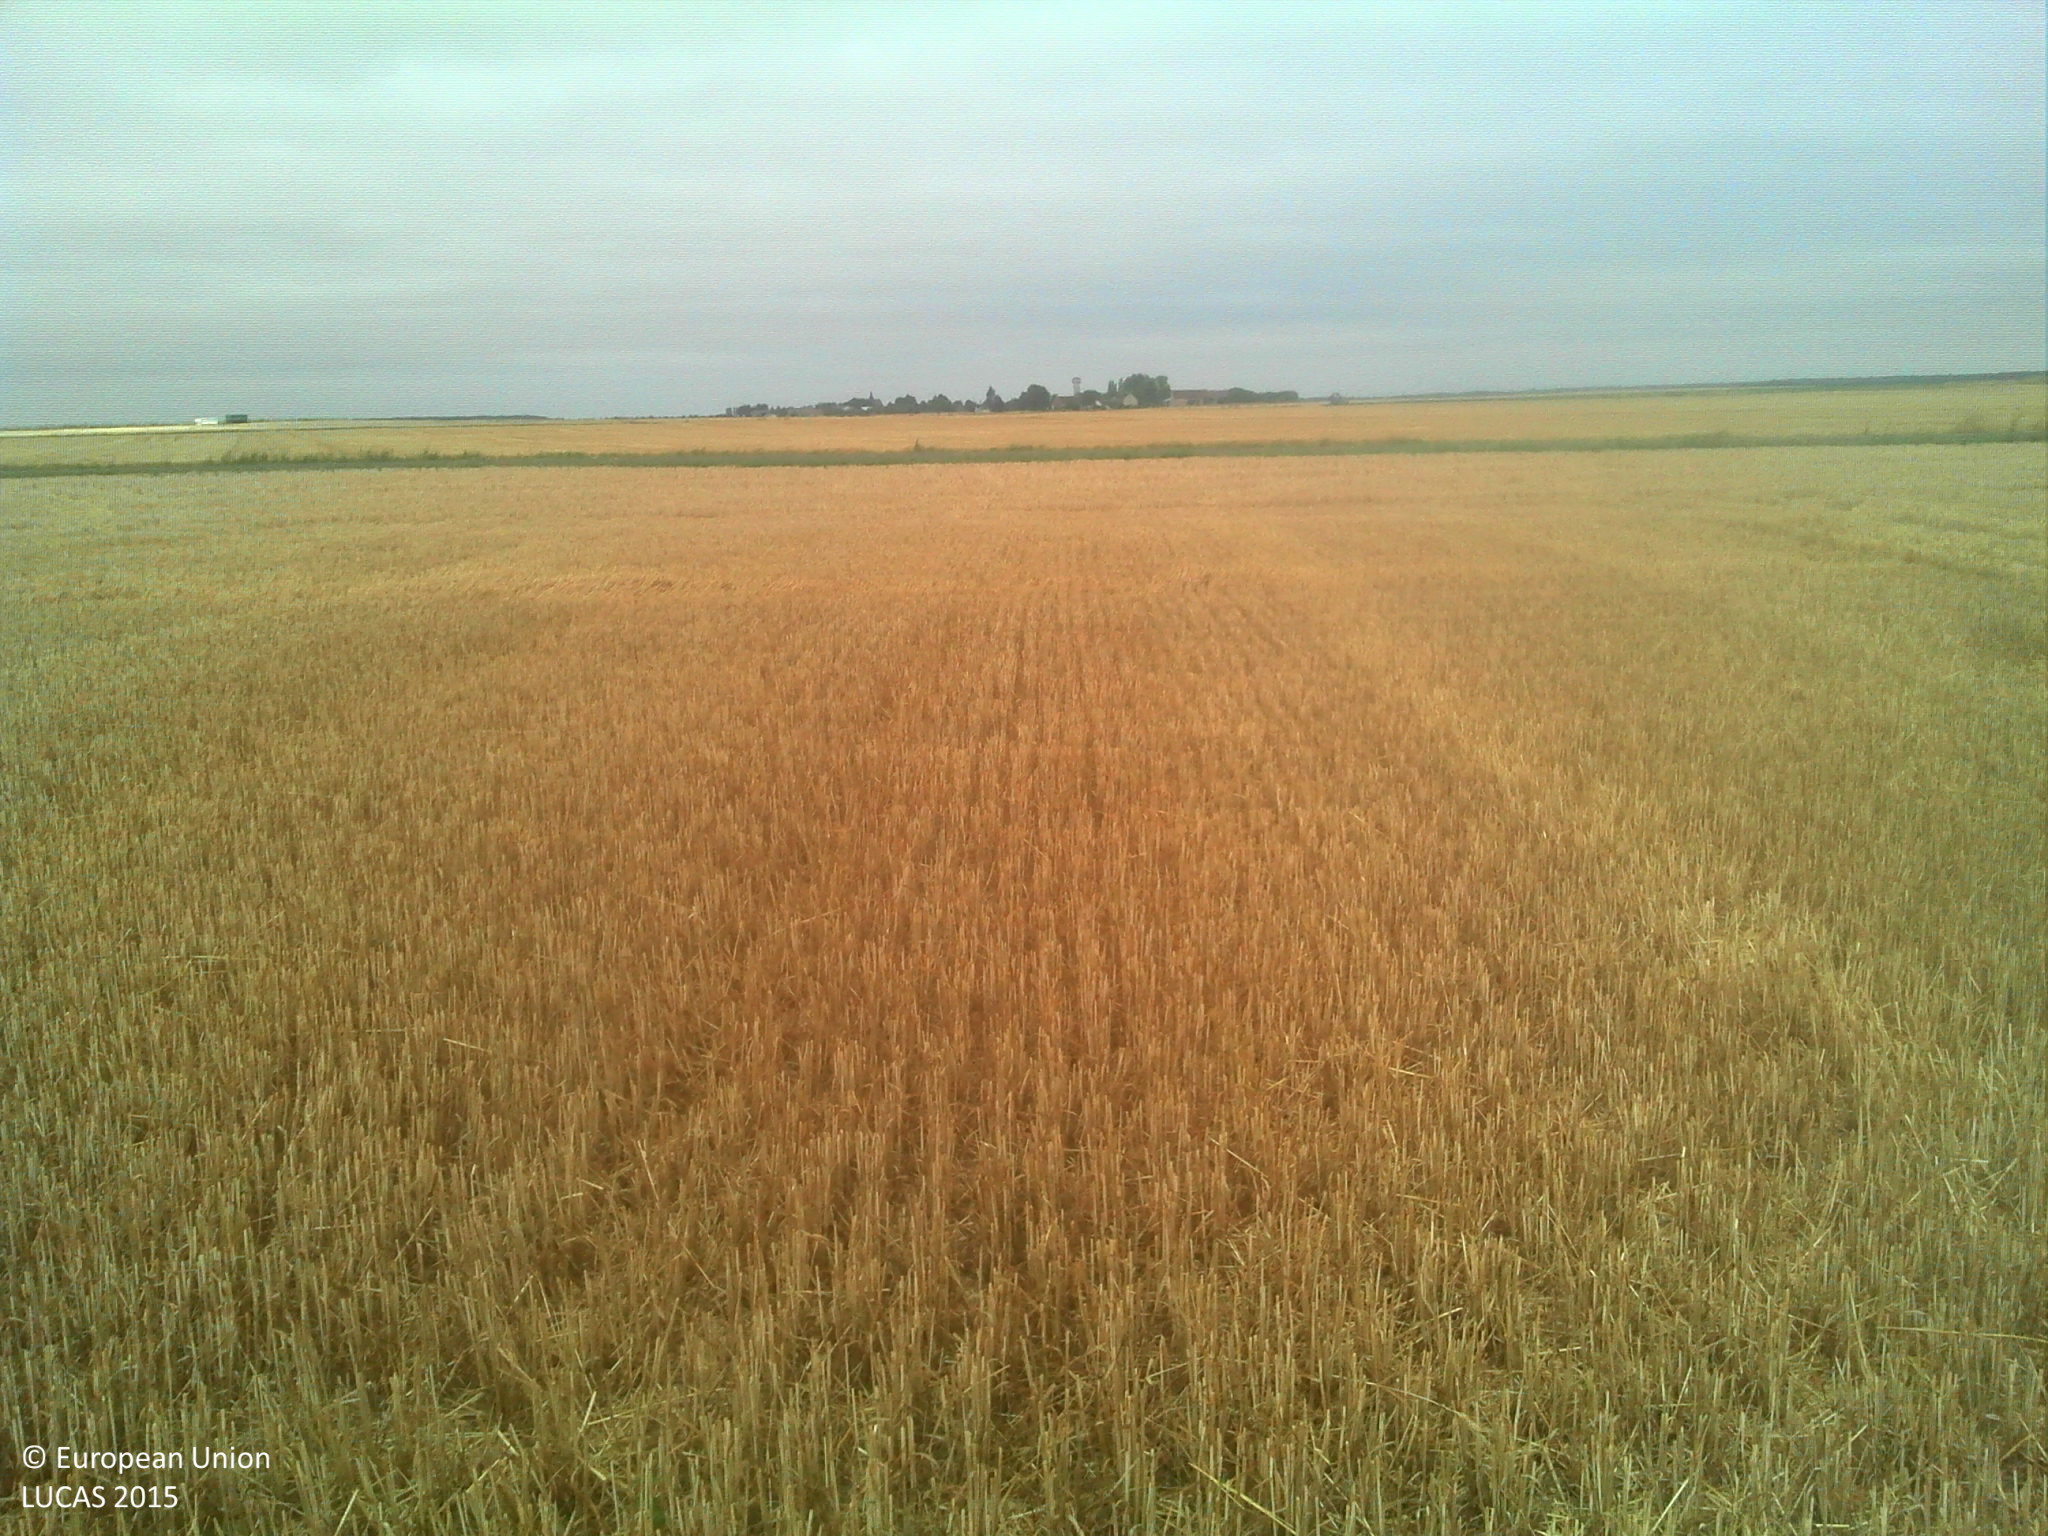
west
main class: Cropland
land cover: Durum wheat
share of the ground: > 75 %
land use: Agriculture (excluding fallow land and kitchen gardens)
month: July
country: FR
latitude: 47.7881
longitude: 1.2941
